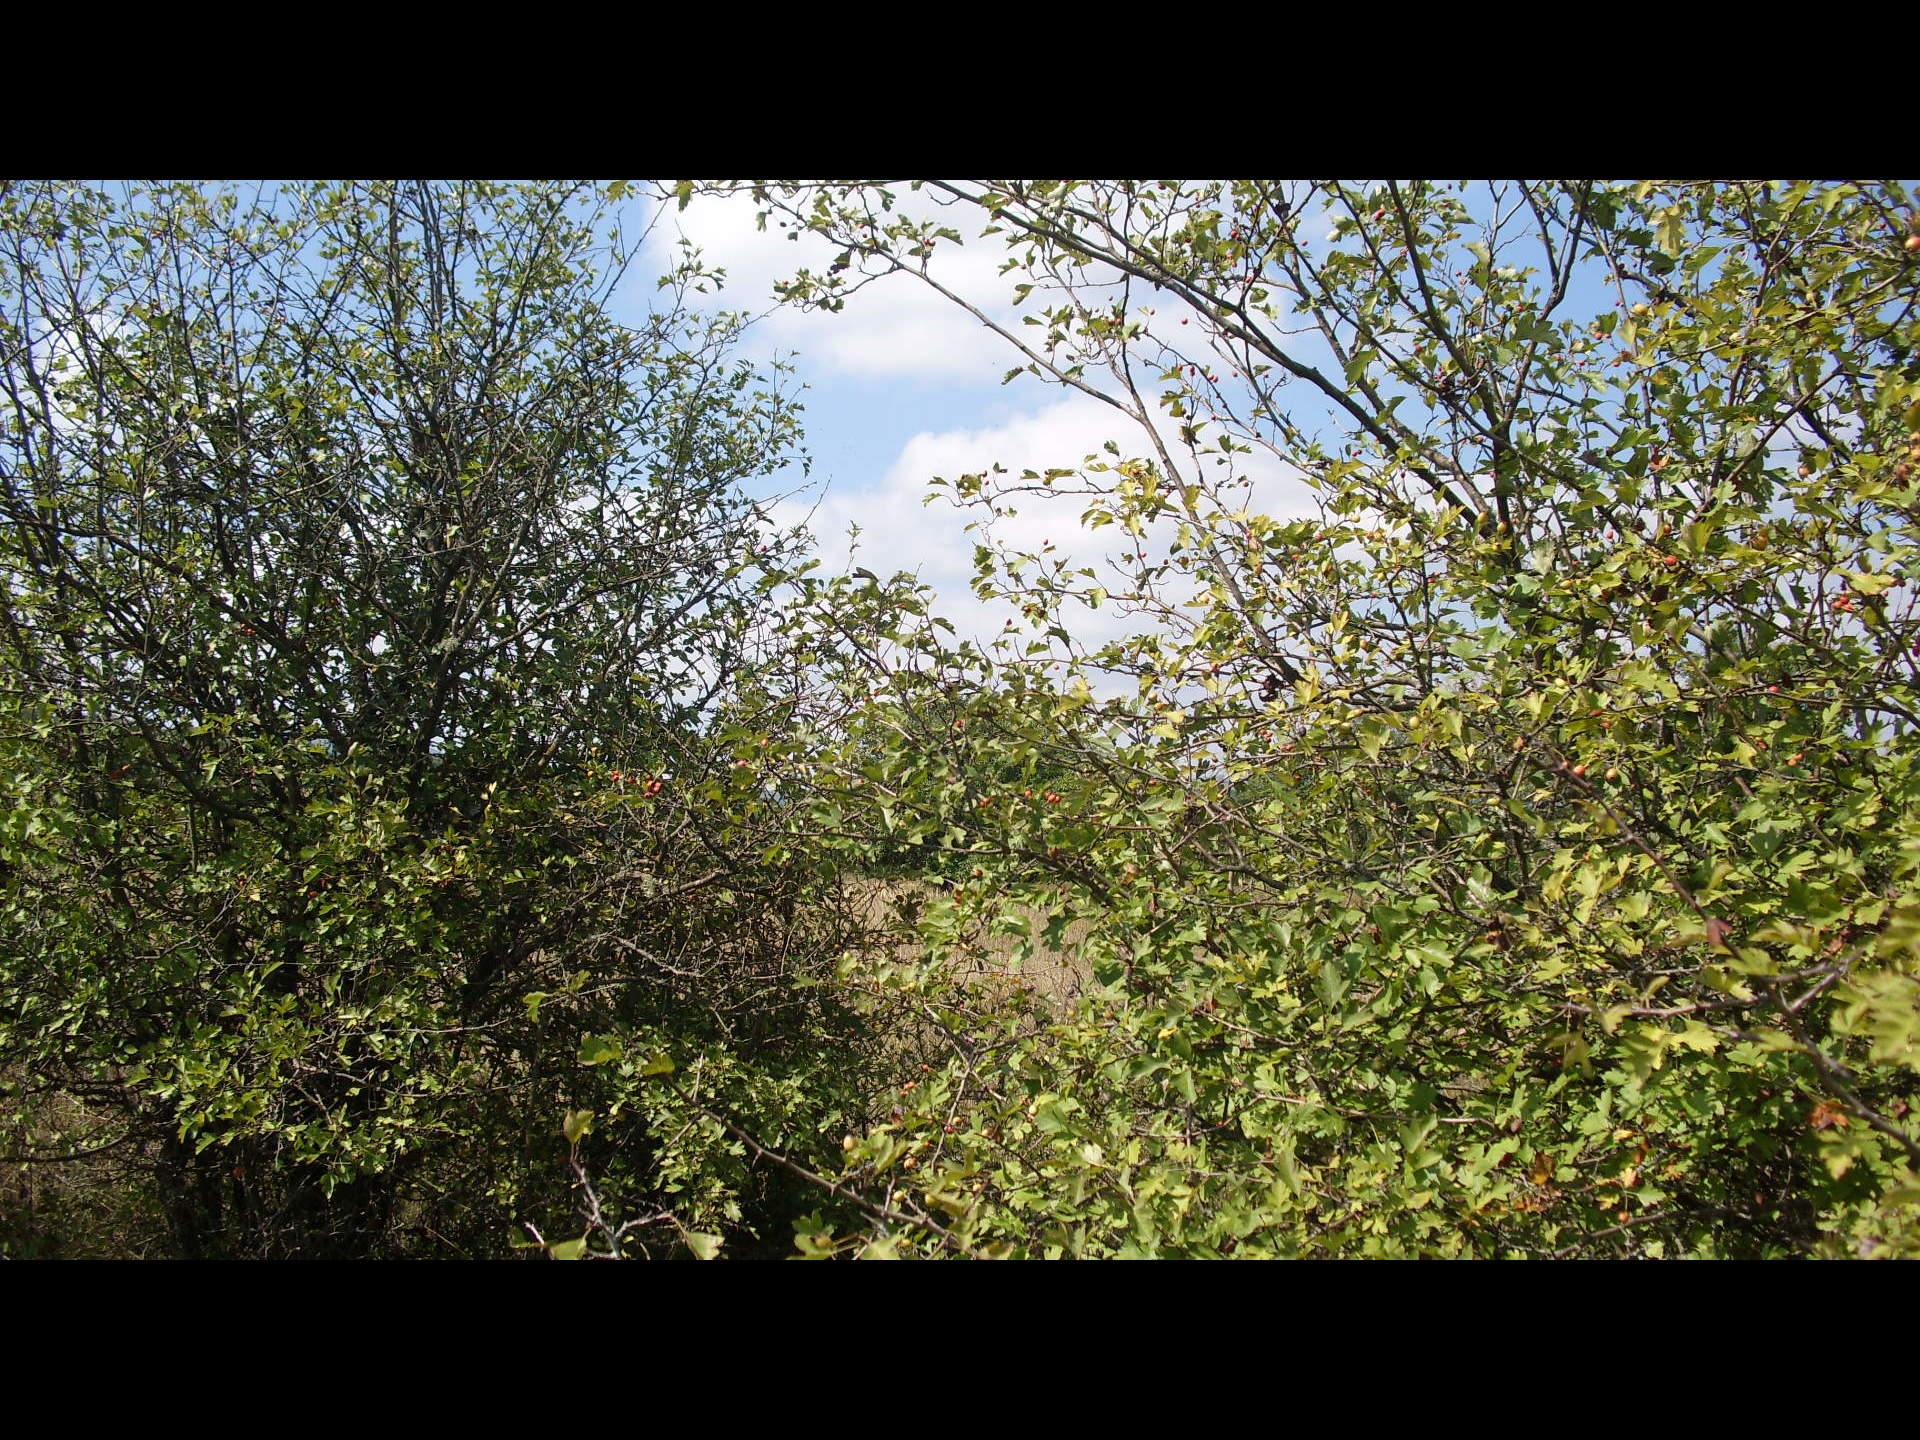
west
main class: Grassland
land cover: Grassland with sparse tree/shrub cover
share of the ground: > 75 %
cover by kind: herbaceous plants 85 %, shrubs 10 %, broadleaved forest trees 5 %
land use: Agriculture (excluding fallow land and kitchen gardens)
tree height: < 5 m
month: August
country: BG
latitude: 43.4933
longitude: 23.1348
